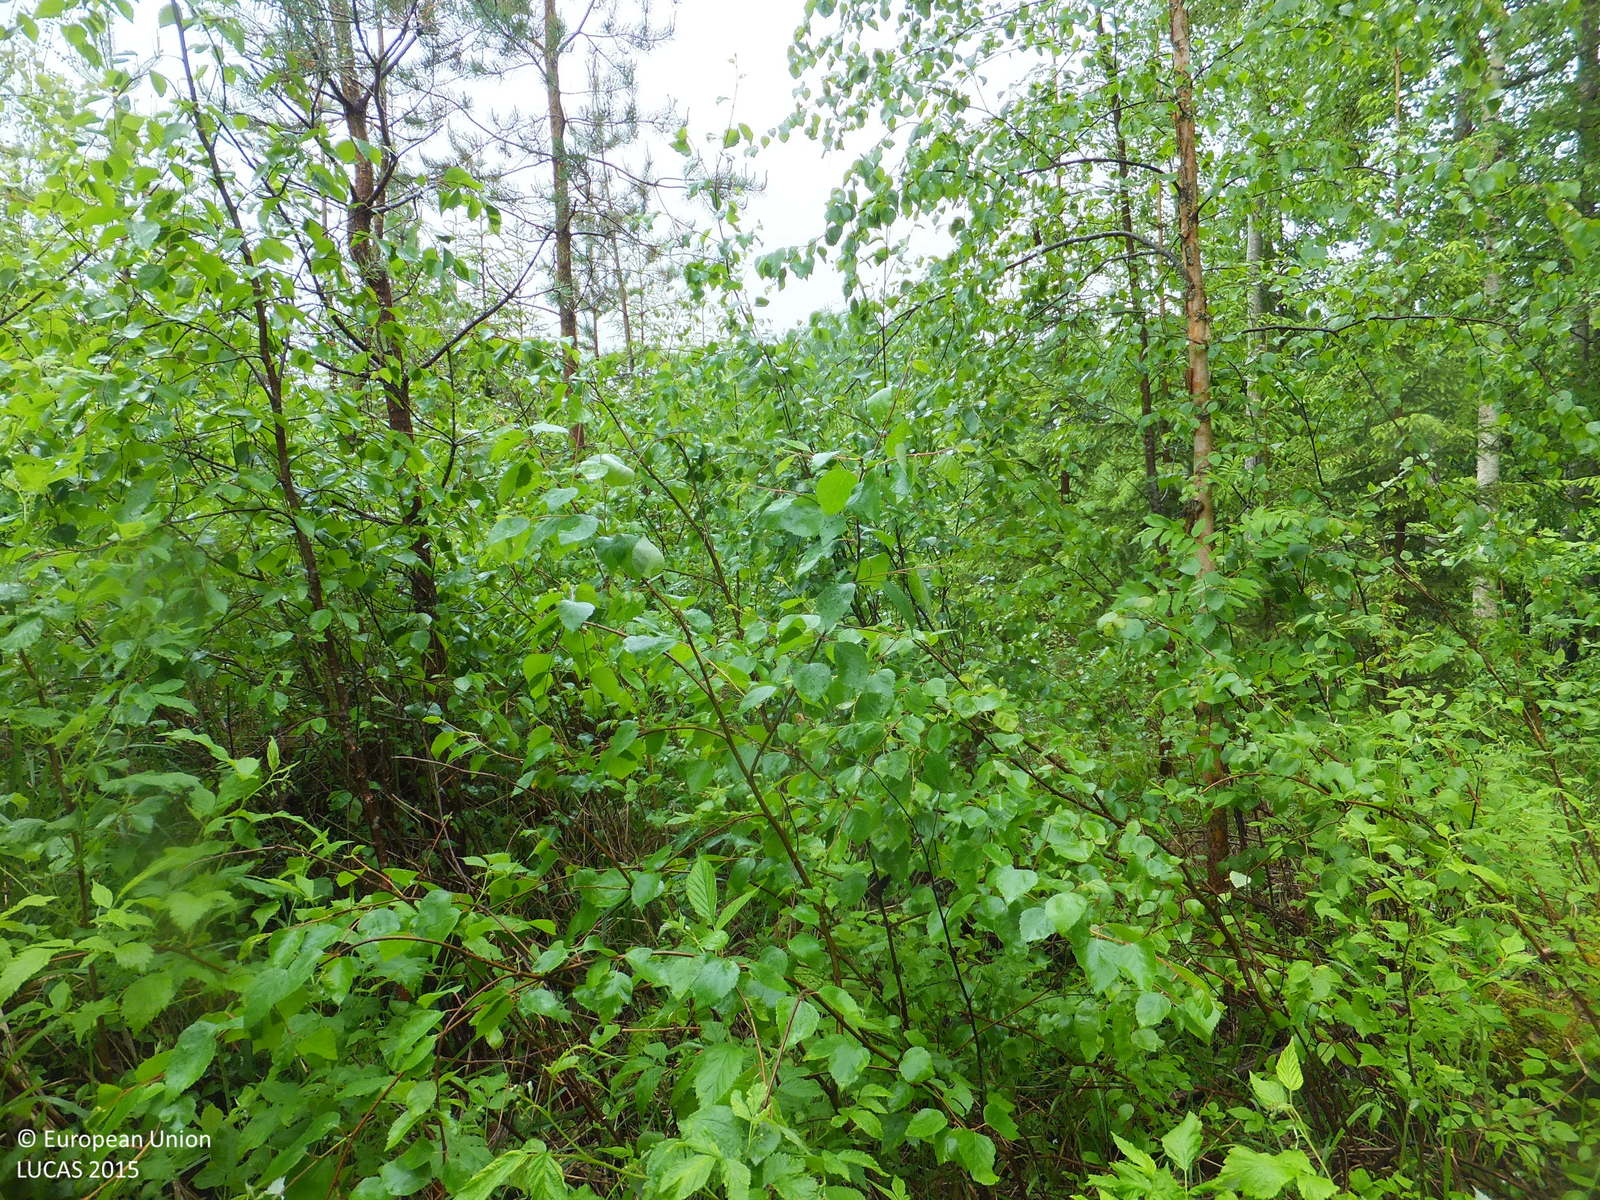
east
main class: Woodland
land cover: Spruce dominated mixed woodland
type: boreal forest
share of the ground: > 75 %
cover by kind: broadleaved forest trees 60 %, coniferous forest trees 25 %, herbaceous plants 10 %, shrubs 5 %
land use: Forestry
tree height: > 5 m
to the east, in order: Spruce dominated mixed woodland; Broadleaved woodland; Ditches and canals; Tracks; Broadleaved woodland; Ditches and canals; Broadleaved woodland
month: June
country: FI
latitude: 63.3571
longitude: 24.9008
